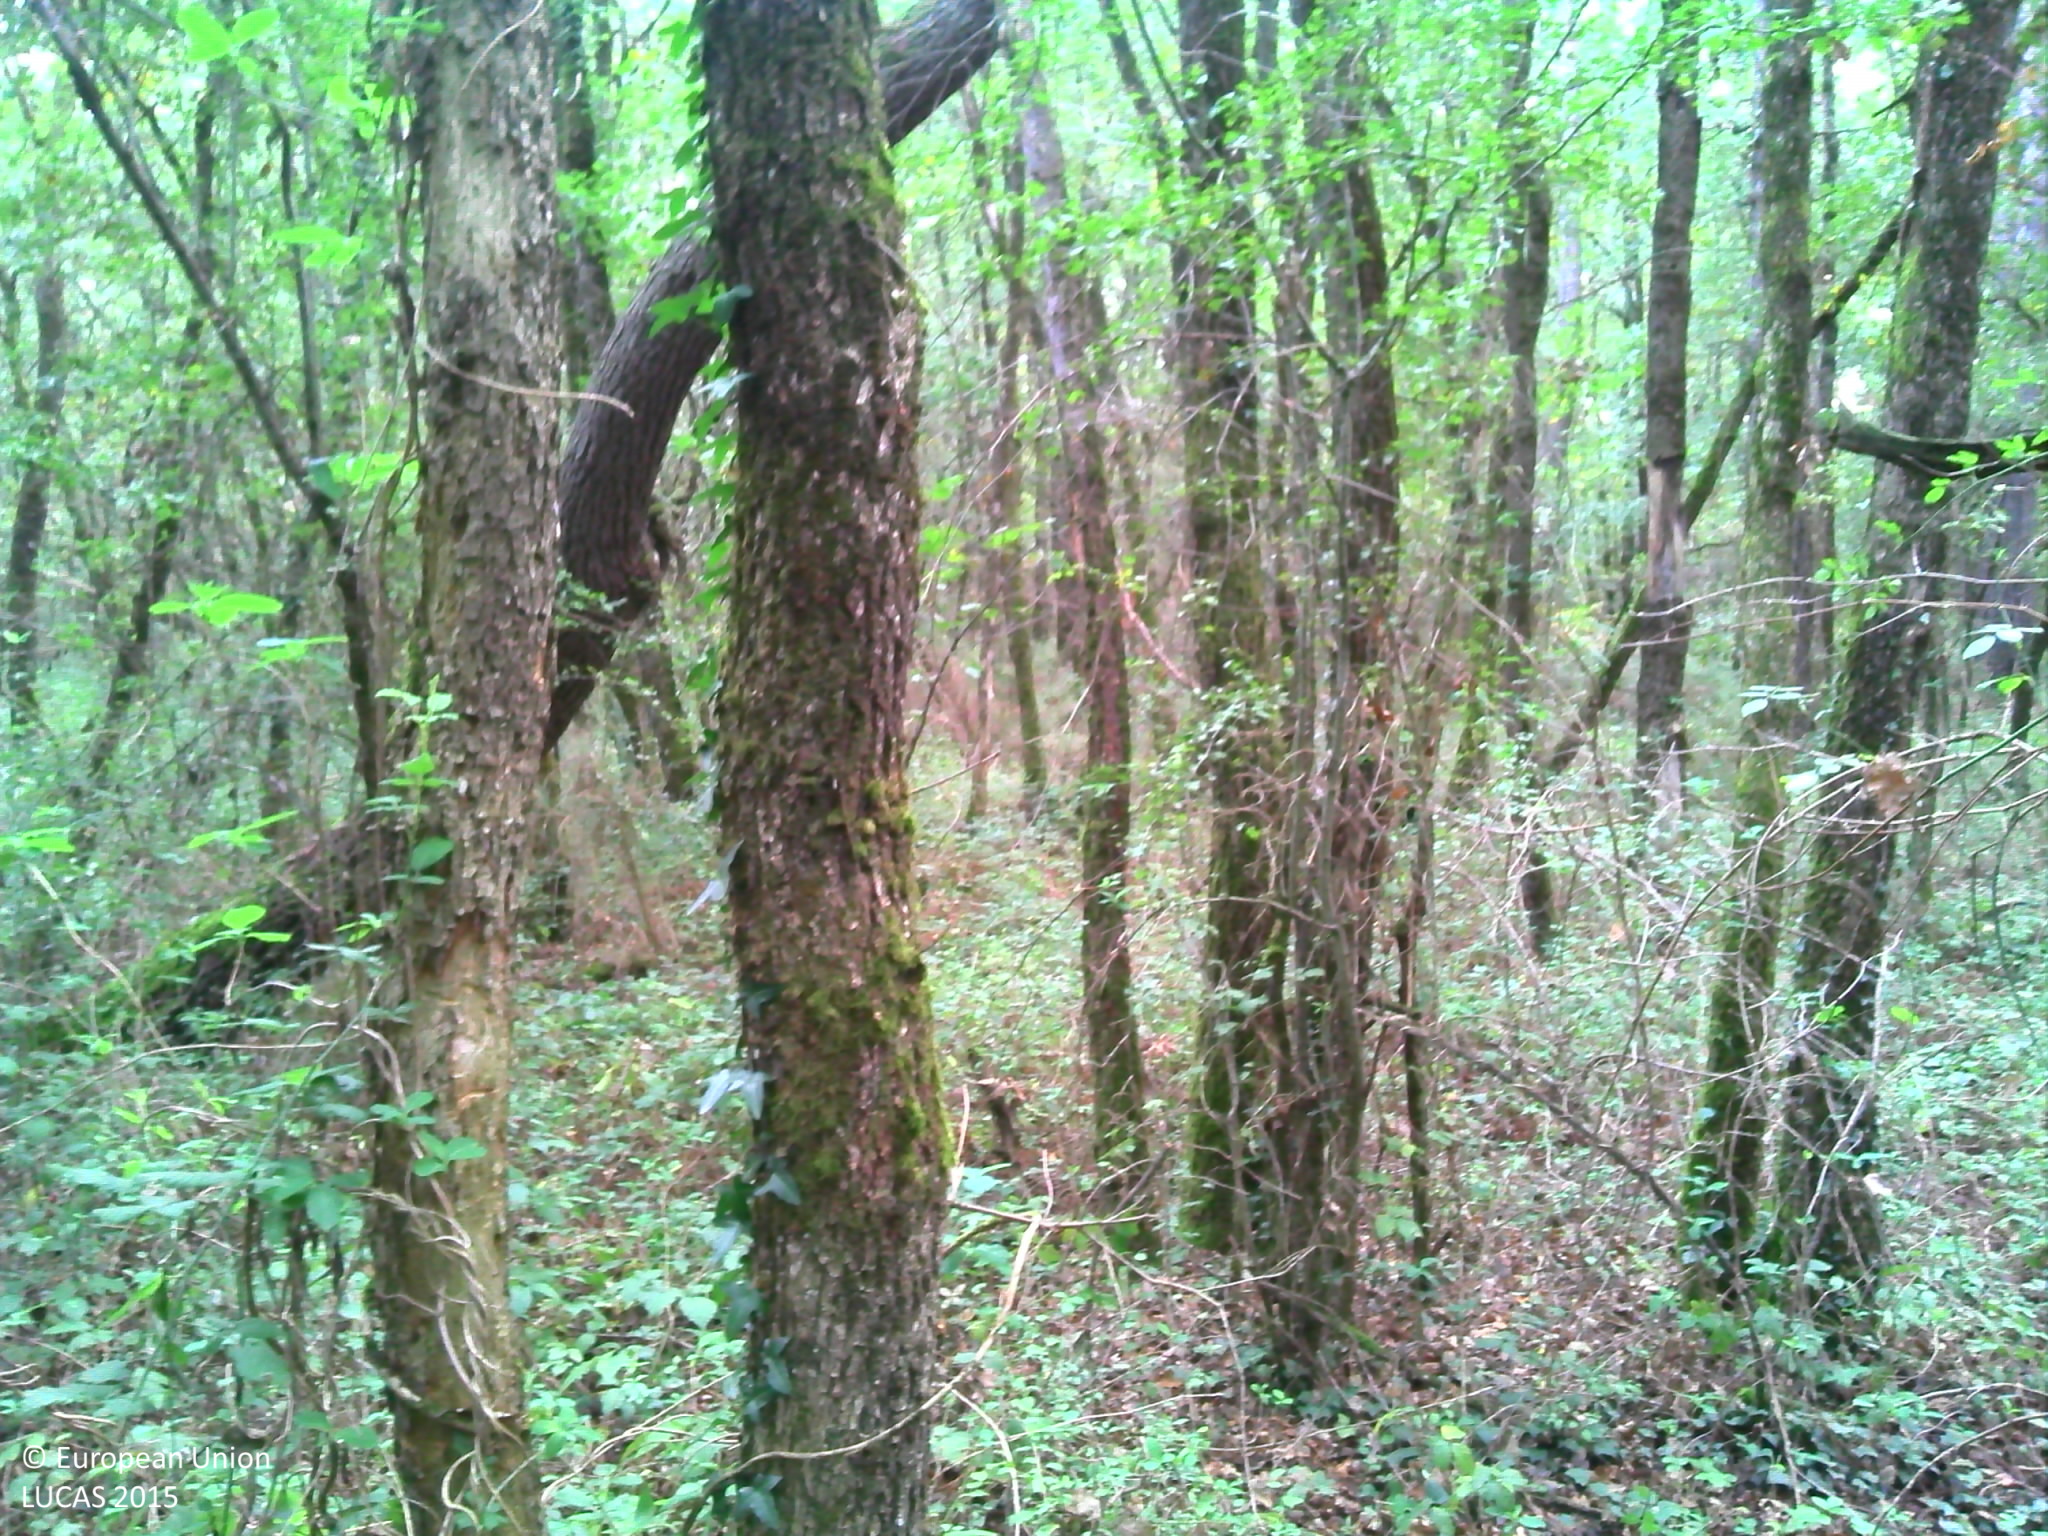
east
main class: Woodland
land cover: Broadleaved woodland
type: mesophytic deciduous forest
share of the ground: > 75 %
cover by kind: broadleaved forest trees 65 %, coniferous forest trees 10 %, shrubs 10 %, herbaceous plants 10 %, lichens and mosses 5 %
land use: Forestry
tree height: > 5 m
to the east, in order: Broadleaved woodland; Ditches and canals; Other fibre and oleaginous crops
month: October
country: FR
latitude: 47.0217
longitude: 0.5742
